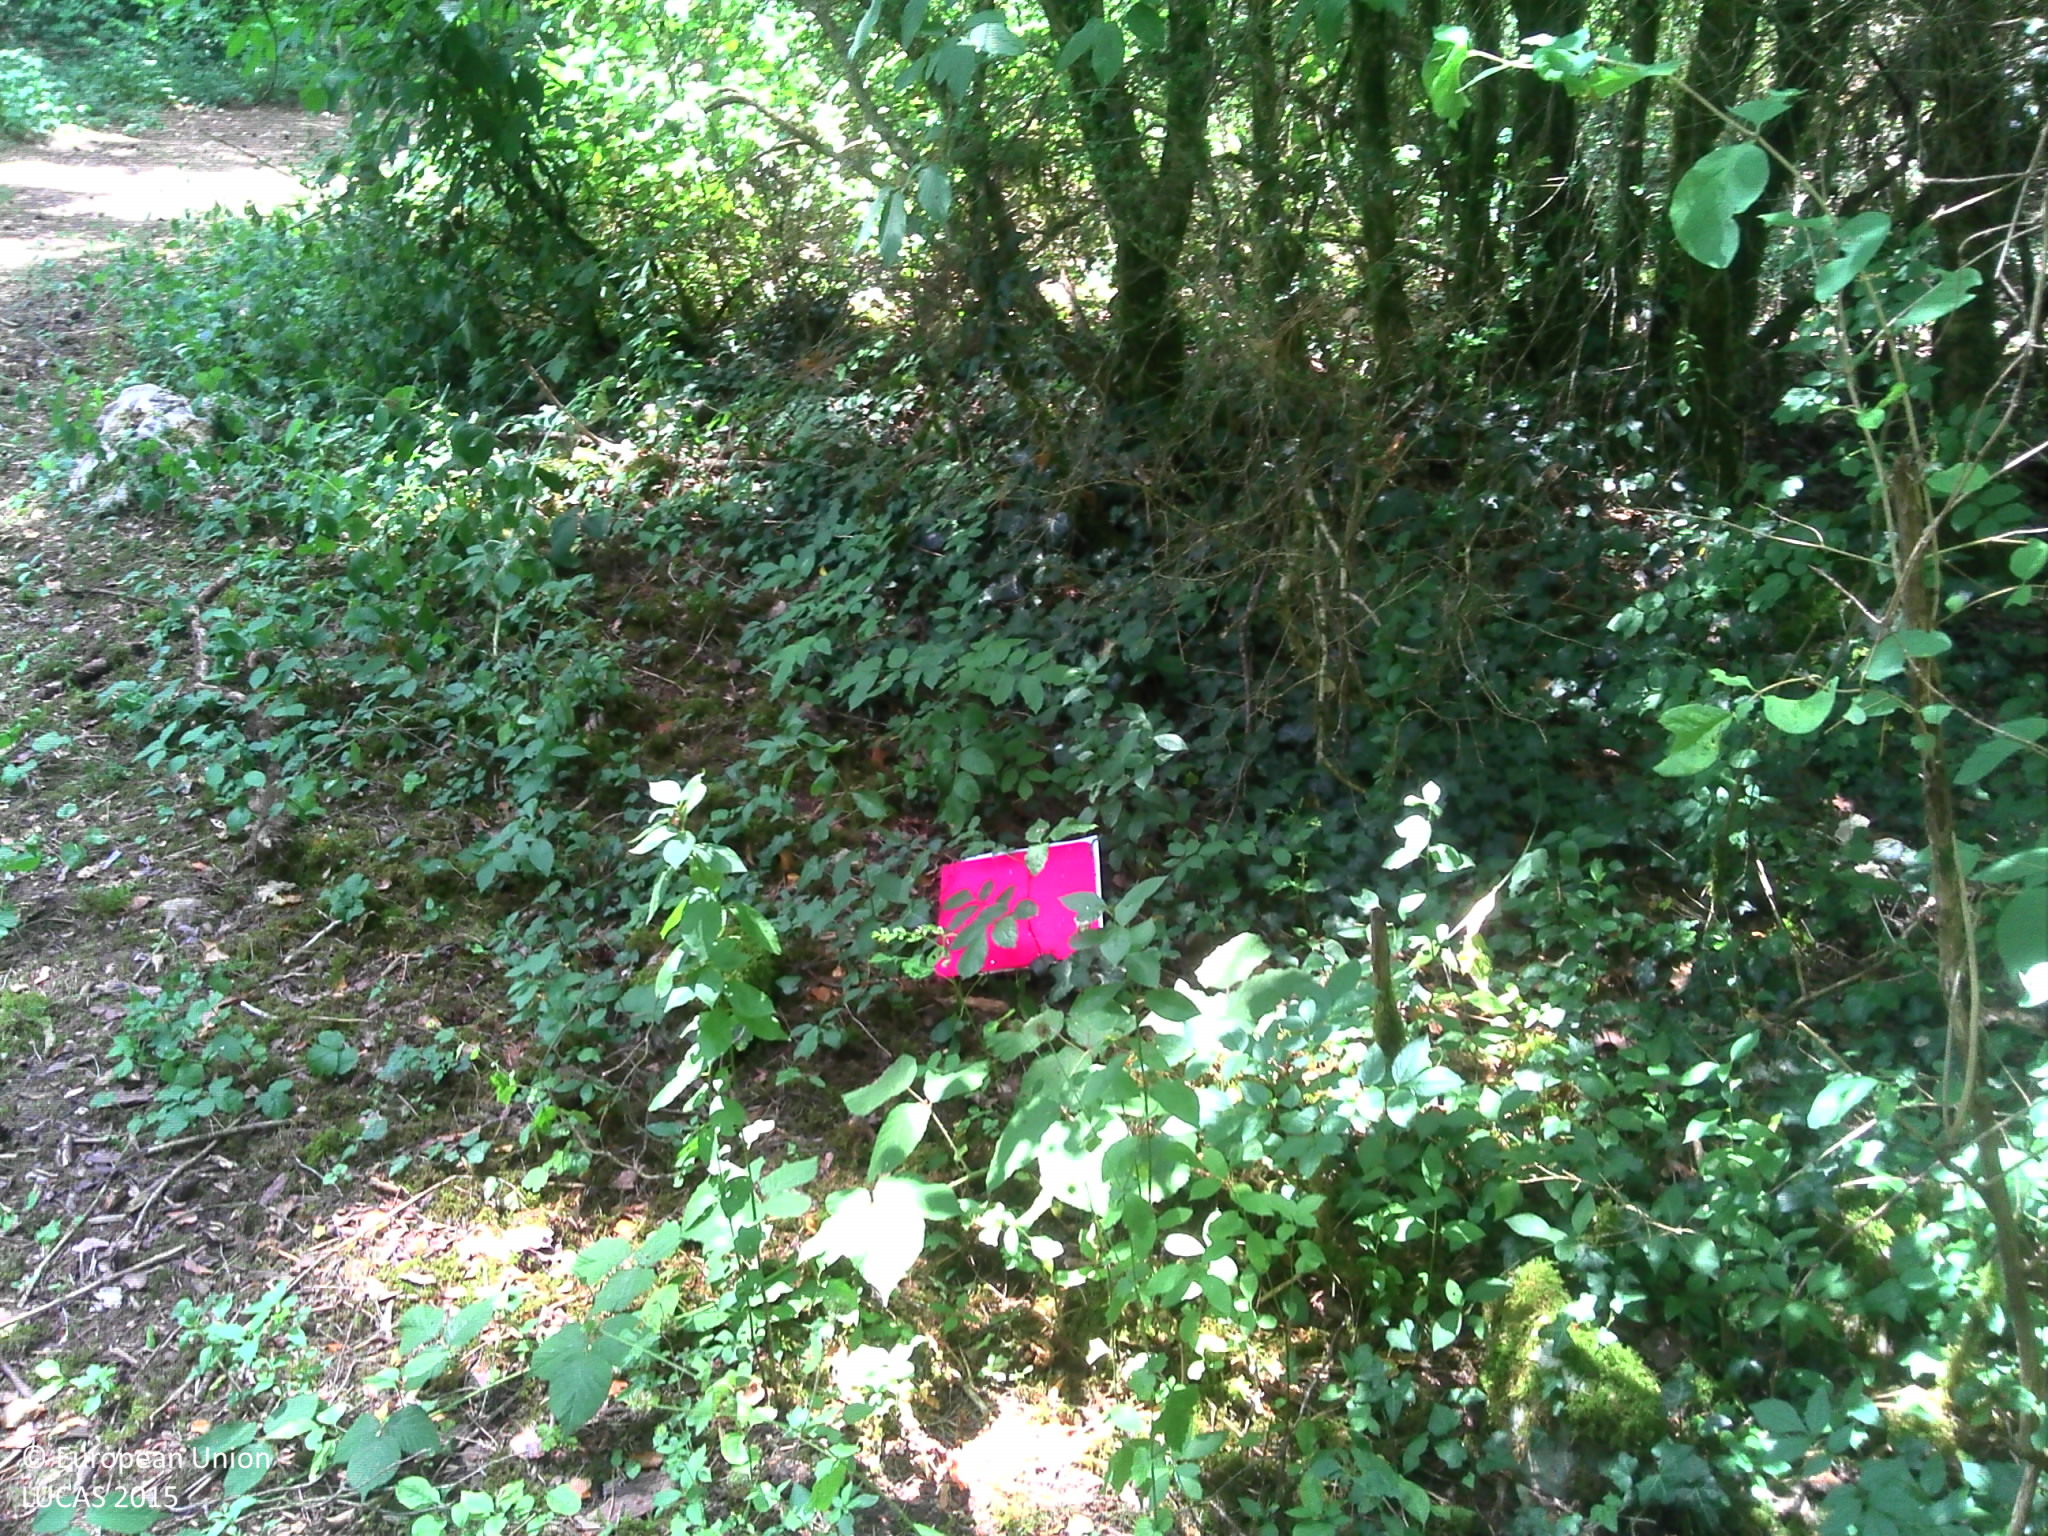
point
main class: Woodland
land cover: Pine dominated mixed woodland
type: hemiboreal forest and nemoral coniferous forest and mixed broadleaved-coniferous forest
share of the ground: > 75 %
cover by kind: coniferous forest trees 30 %, broadleaved forest trees 30 %, herbaceous plants 25 %, lichens and mosses 10 %, shrubs 5 %
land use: Forestry
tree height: > 5 m
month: July
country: FR
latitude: 46.1246
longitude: 6.2894
